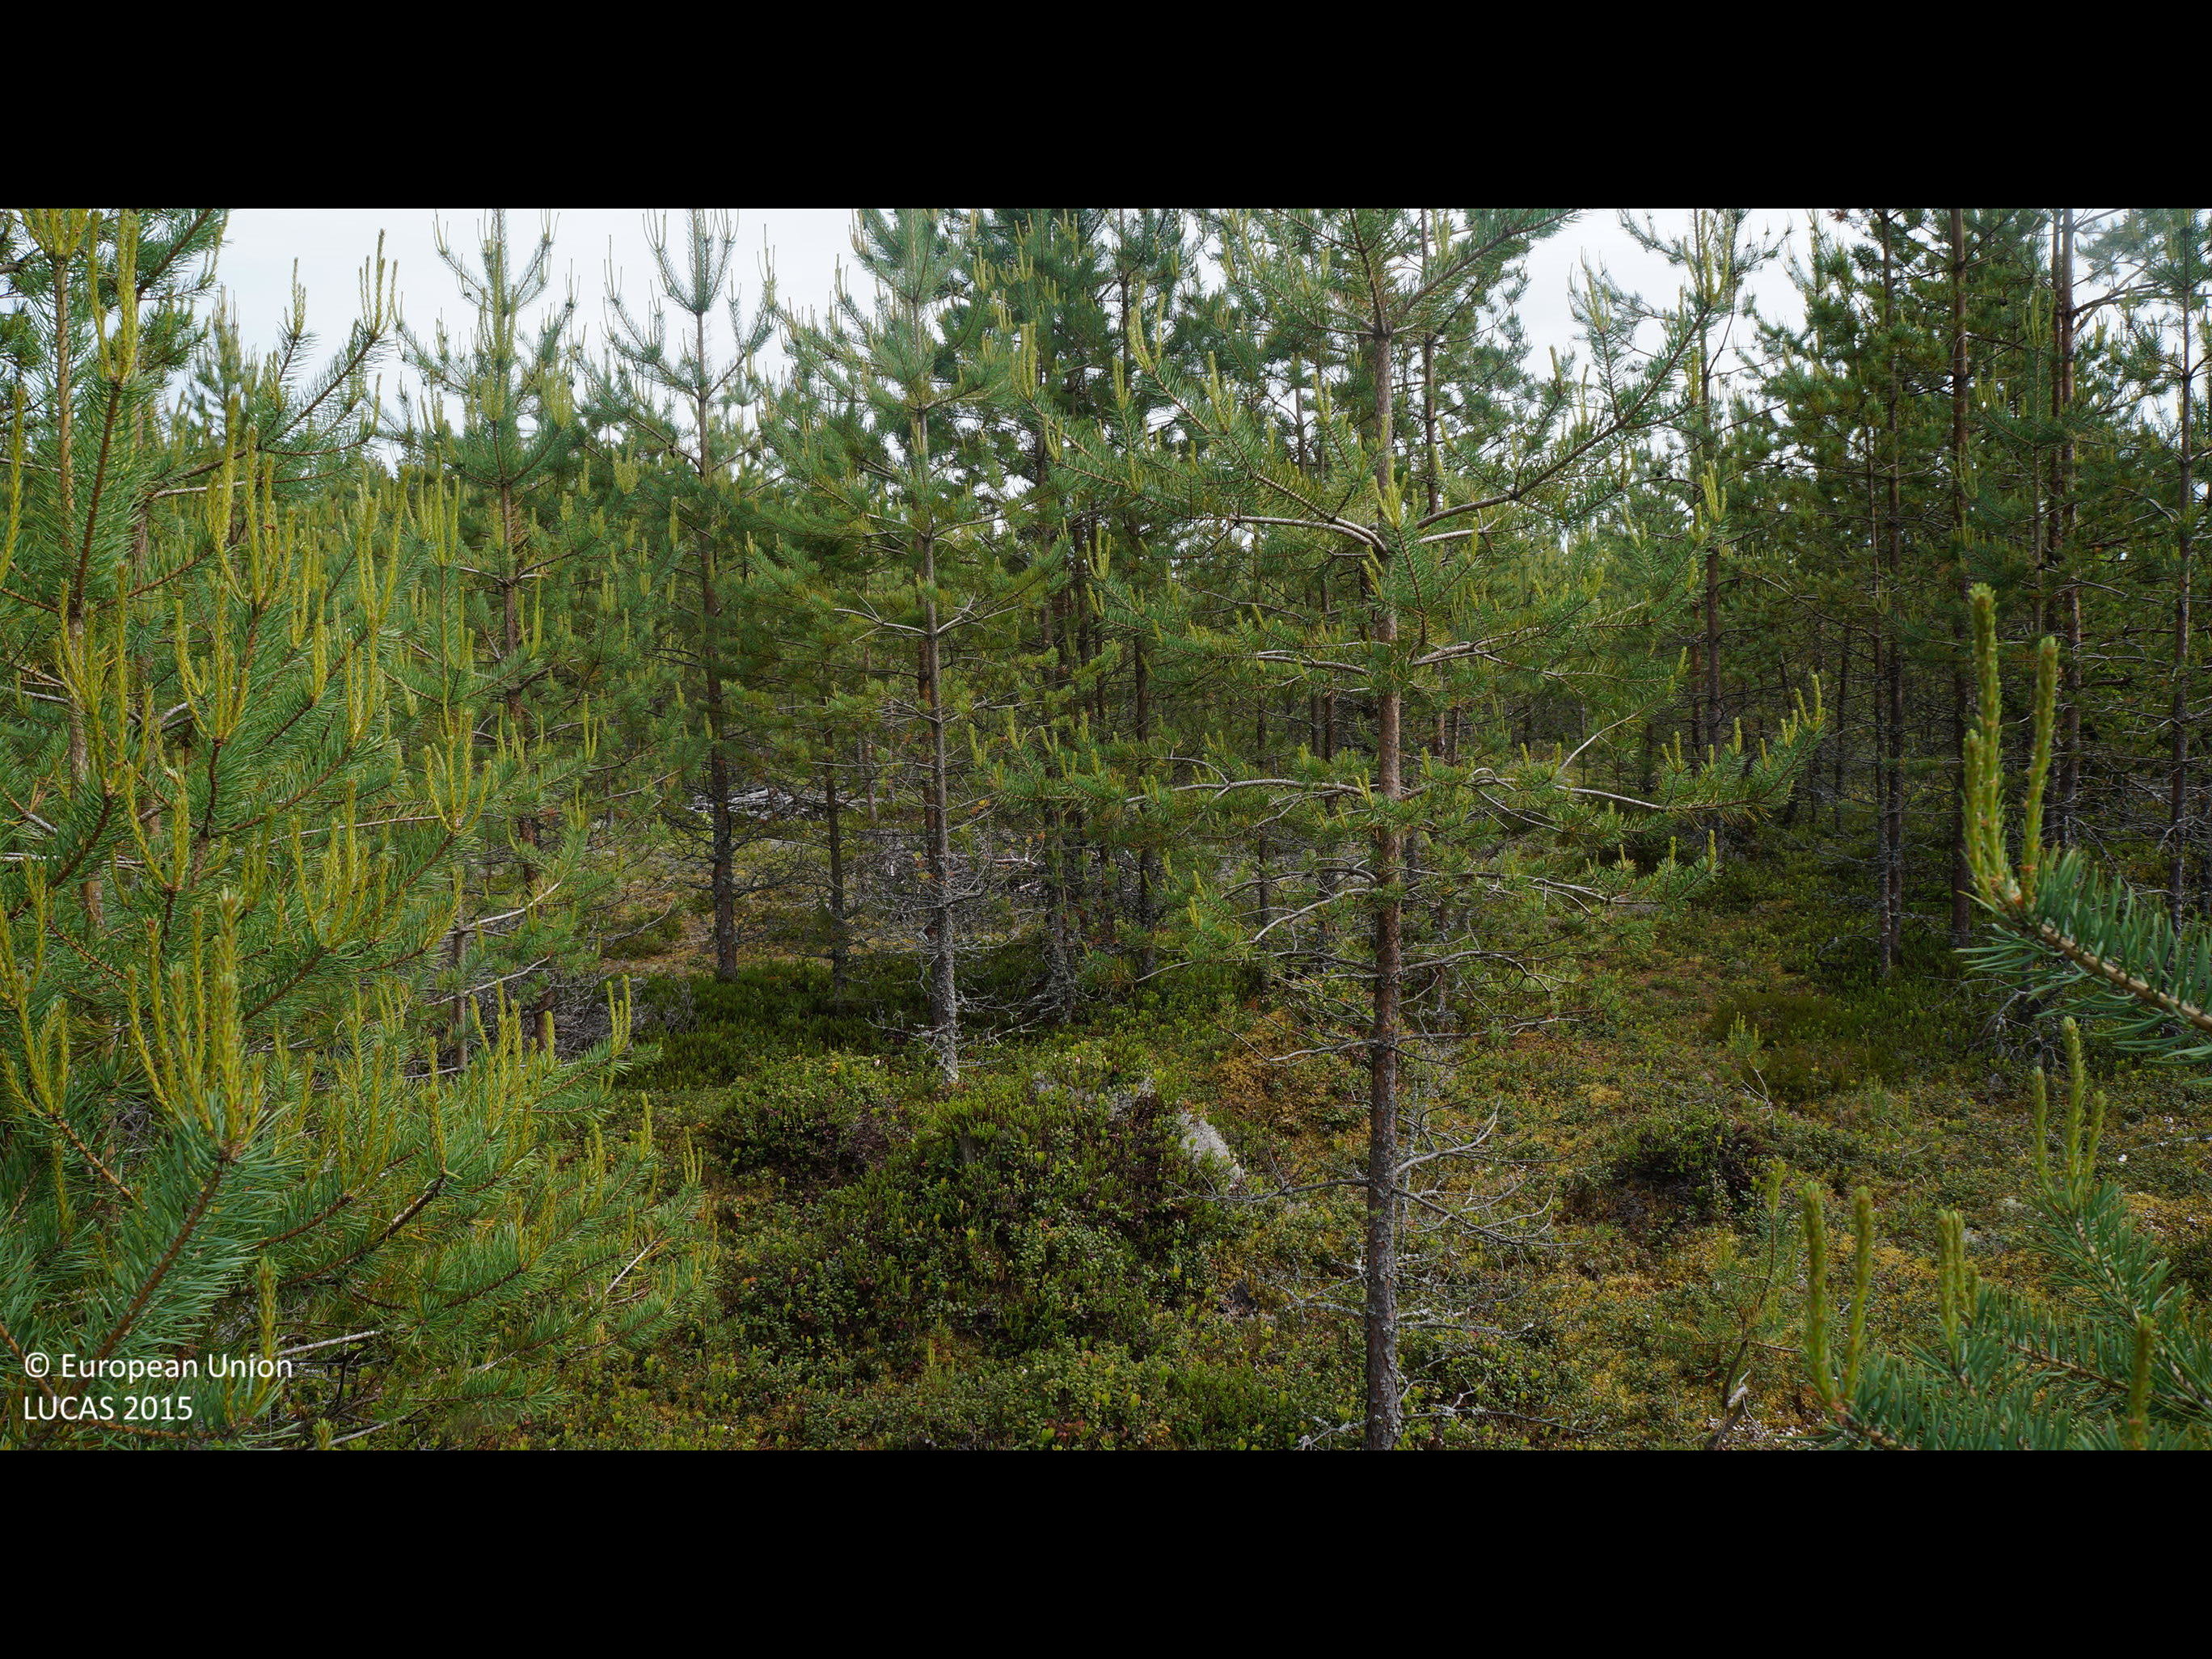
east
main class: Woodland
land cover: Pine dominated coniferous woodland
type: boreal forest
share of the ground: 25 - 50 %
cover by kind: coniferous forest trees 40 %, shrubs 40 %, lichens and mosses 20 %
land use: Forestry
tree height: > 5 m
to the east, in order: Pine dominated coniferous woodland; Pine dominated mixed woodland; Tracks; Pine dominated mixed woodland; Pine dominated coniferous woodland; Tracks; Pine dominated coniferous woodland; Tracks; Pine dominated coniferous woodland
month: June
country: FI
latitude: 63.8036
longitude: 23.0256
